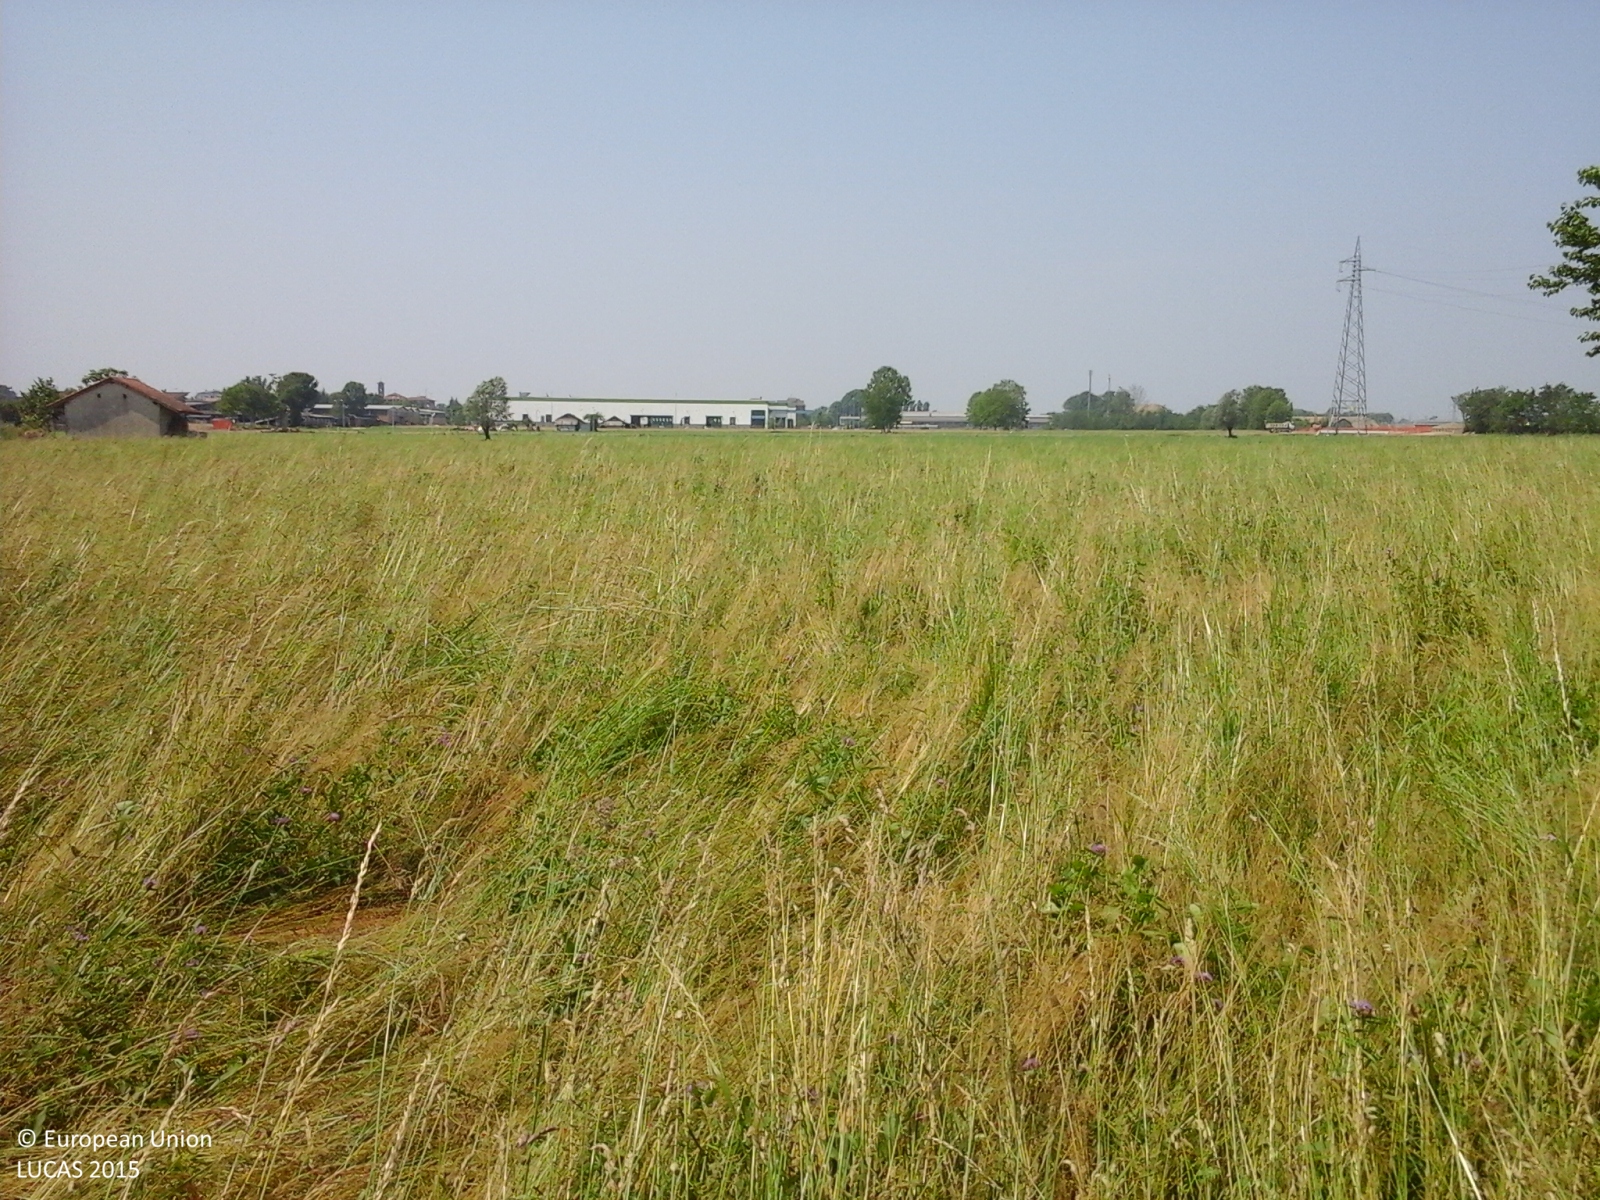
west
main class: Grassland
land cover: Grassland with sparse tree/shrub cover
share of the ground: > 75 %
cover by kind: herbaceous plants 95 %, broadleaved forest trees 5 %
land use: Agriculture (excluding fallow land and kitchen gardens)
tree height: < 5 m
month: May
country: IT
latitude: 45.5568
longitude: 9.3989
